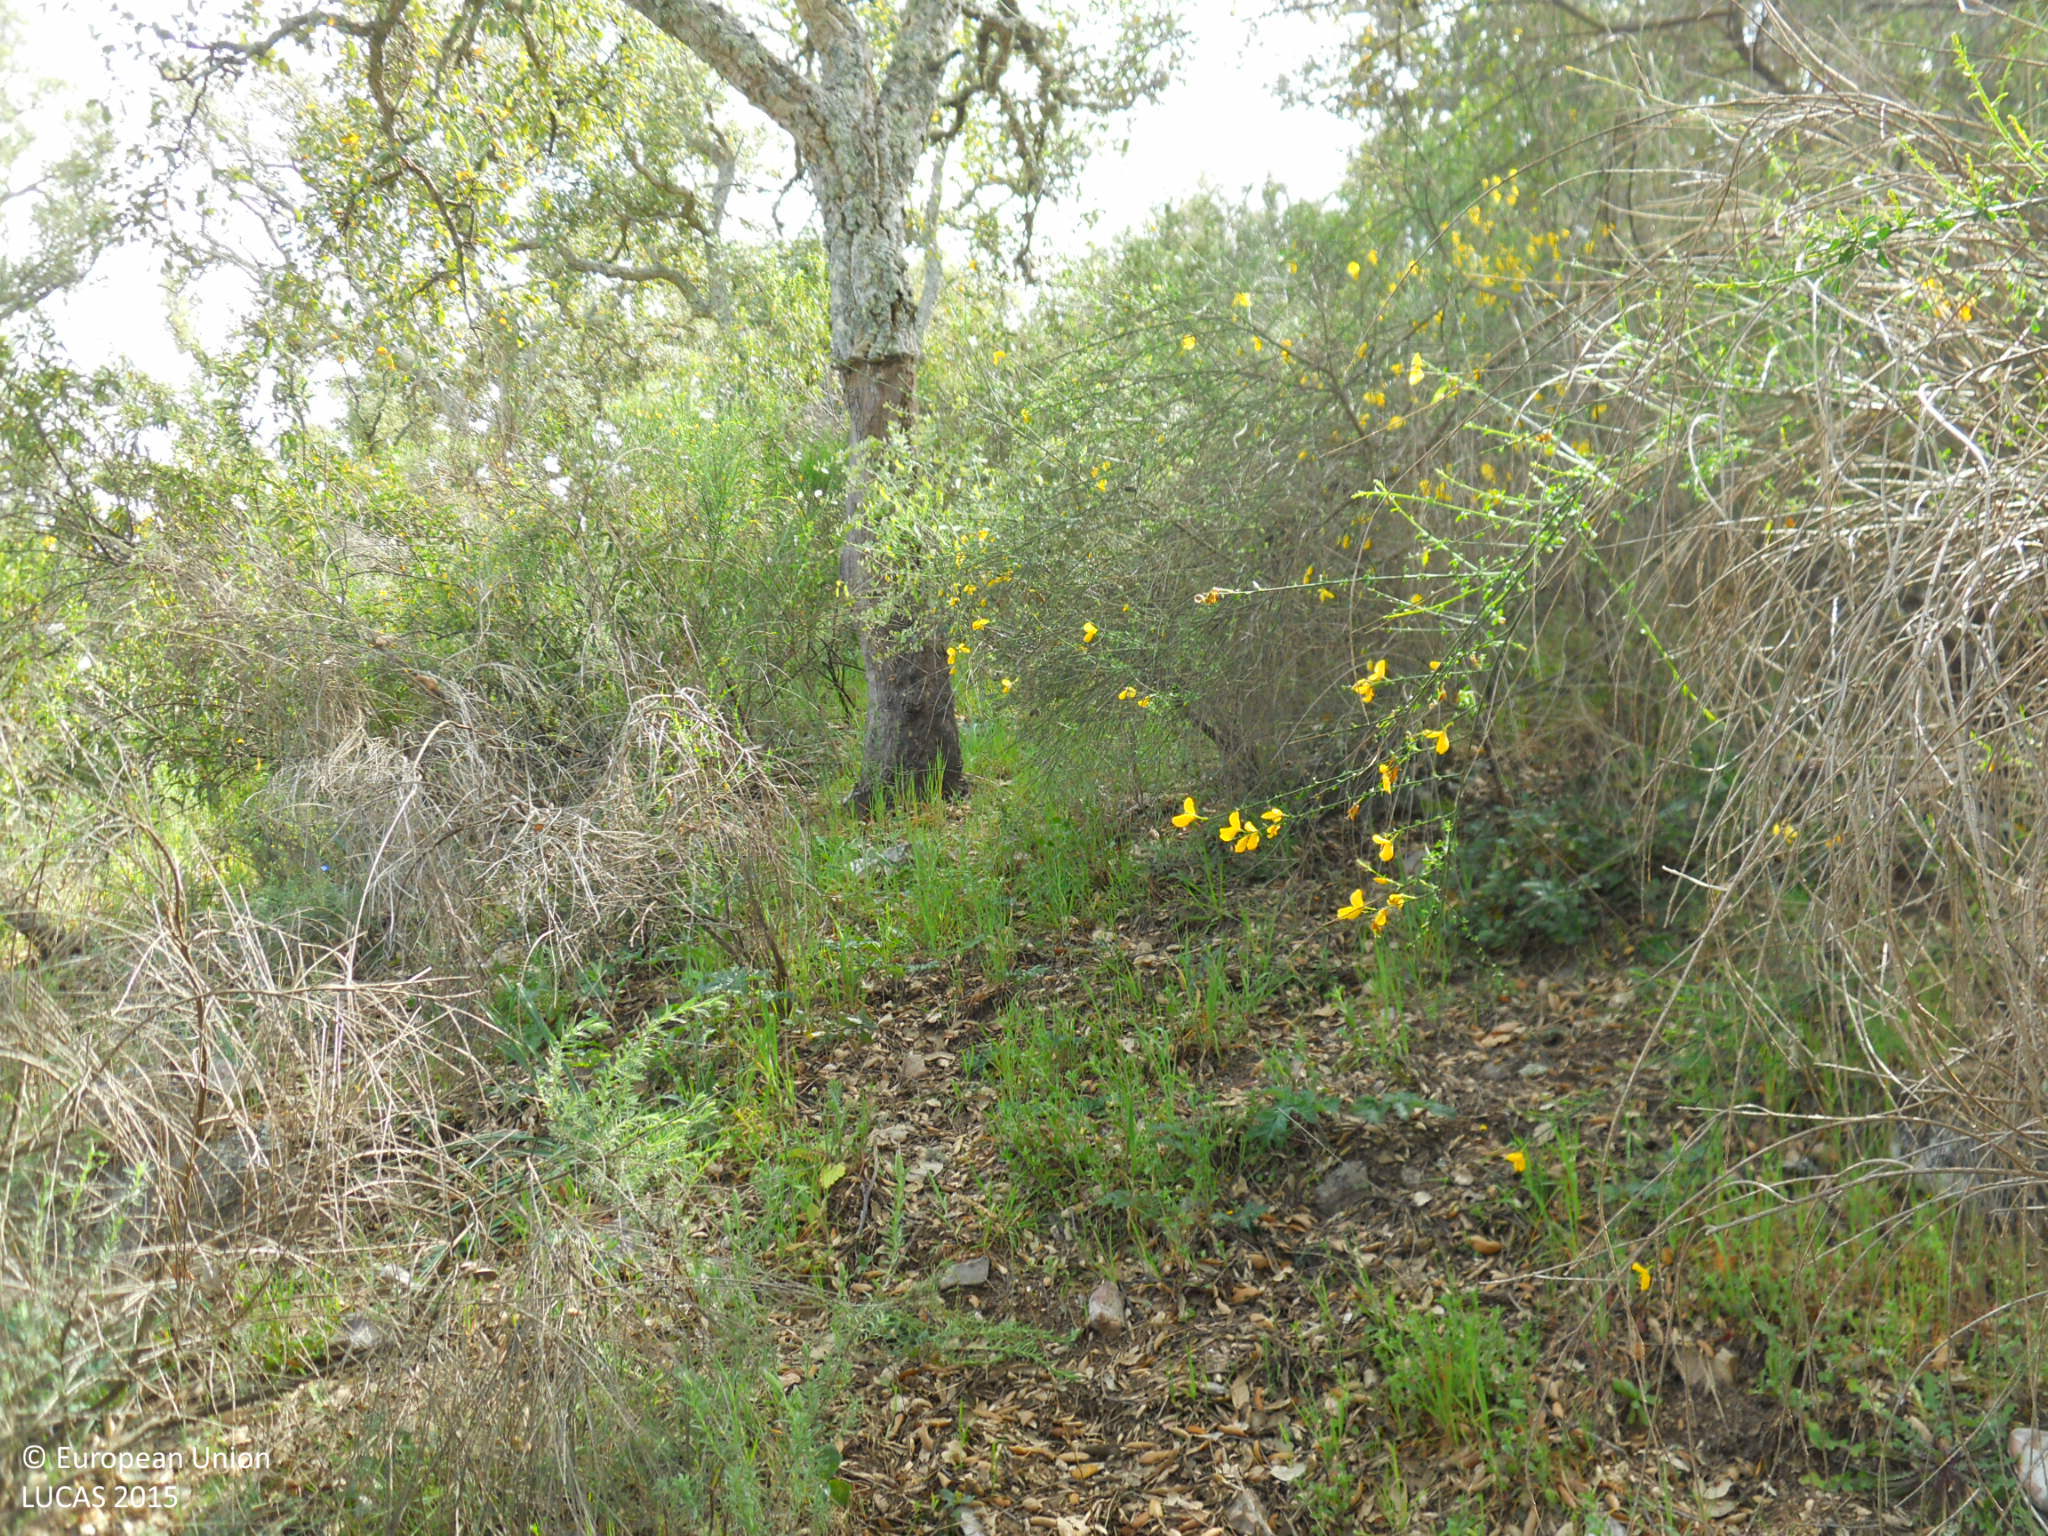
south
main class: Woodland
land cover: Broadleaved woodland
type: broadleaved evergreen forest
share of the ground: > 75 %
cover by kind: broadleaved forest trees 100 %
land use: Forestry
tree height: > 5 m
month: April
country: ES
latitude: 39.1900
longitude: -6.6125
